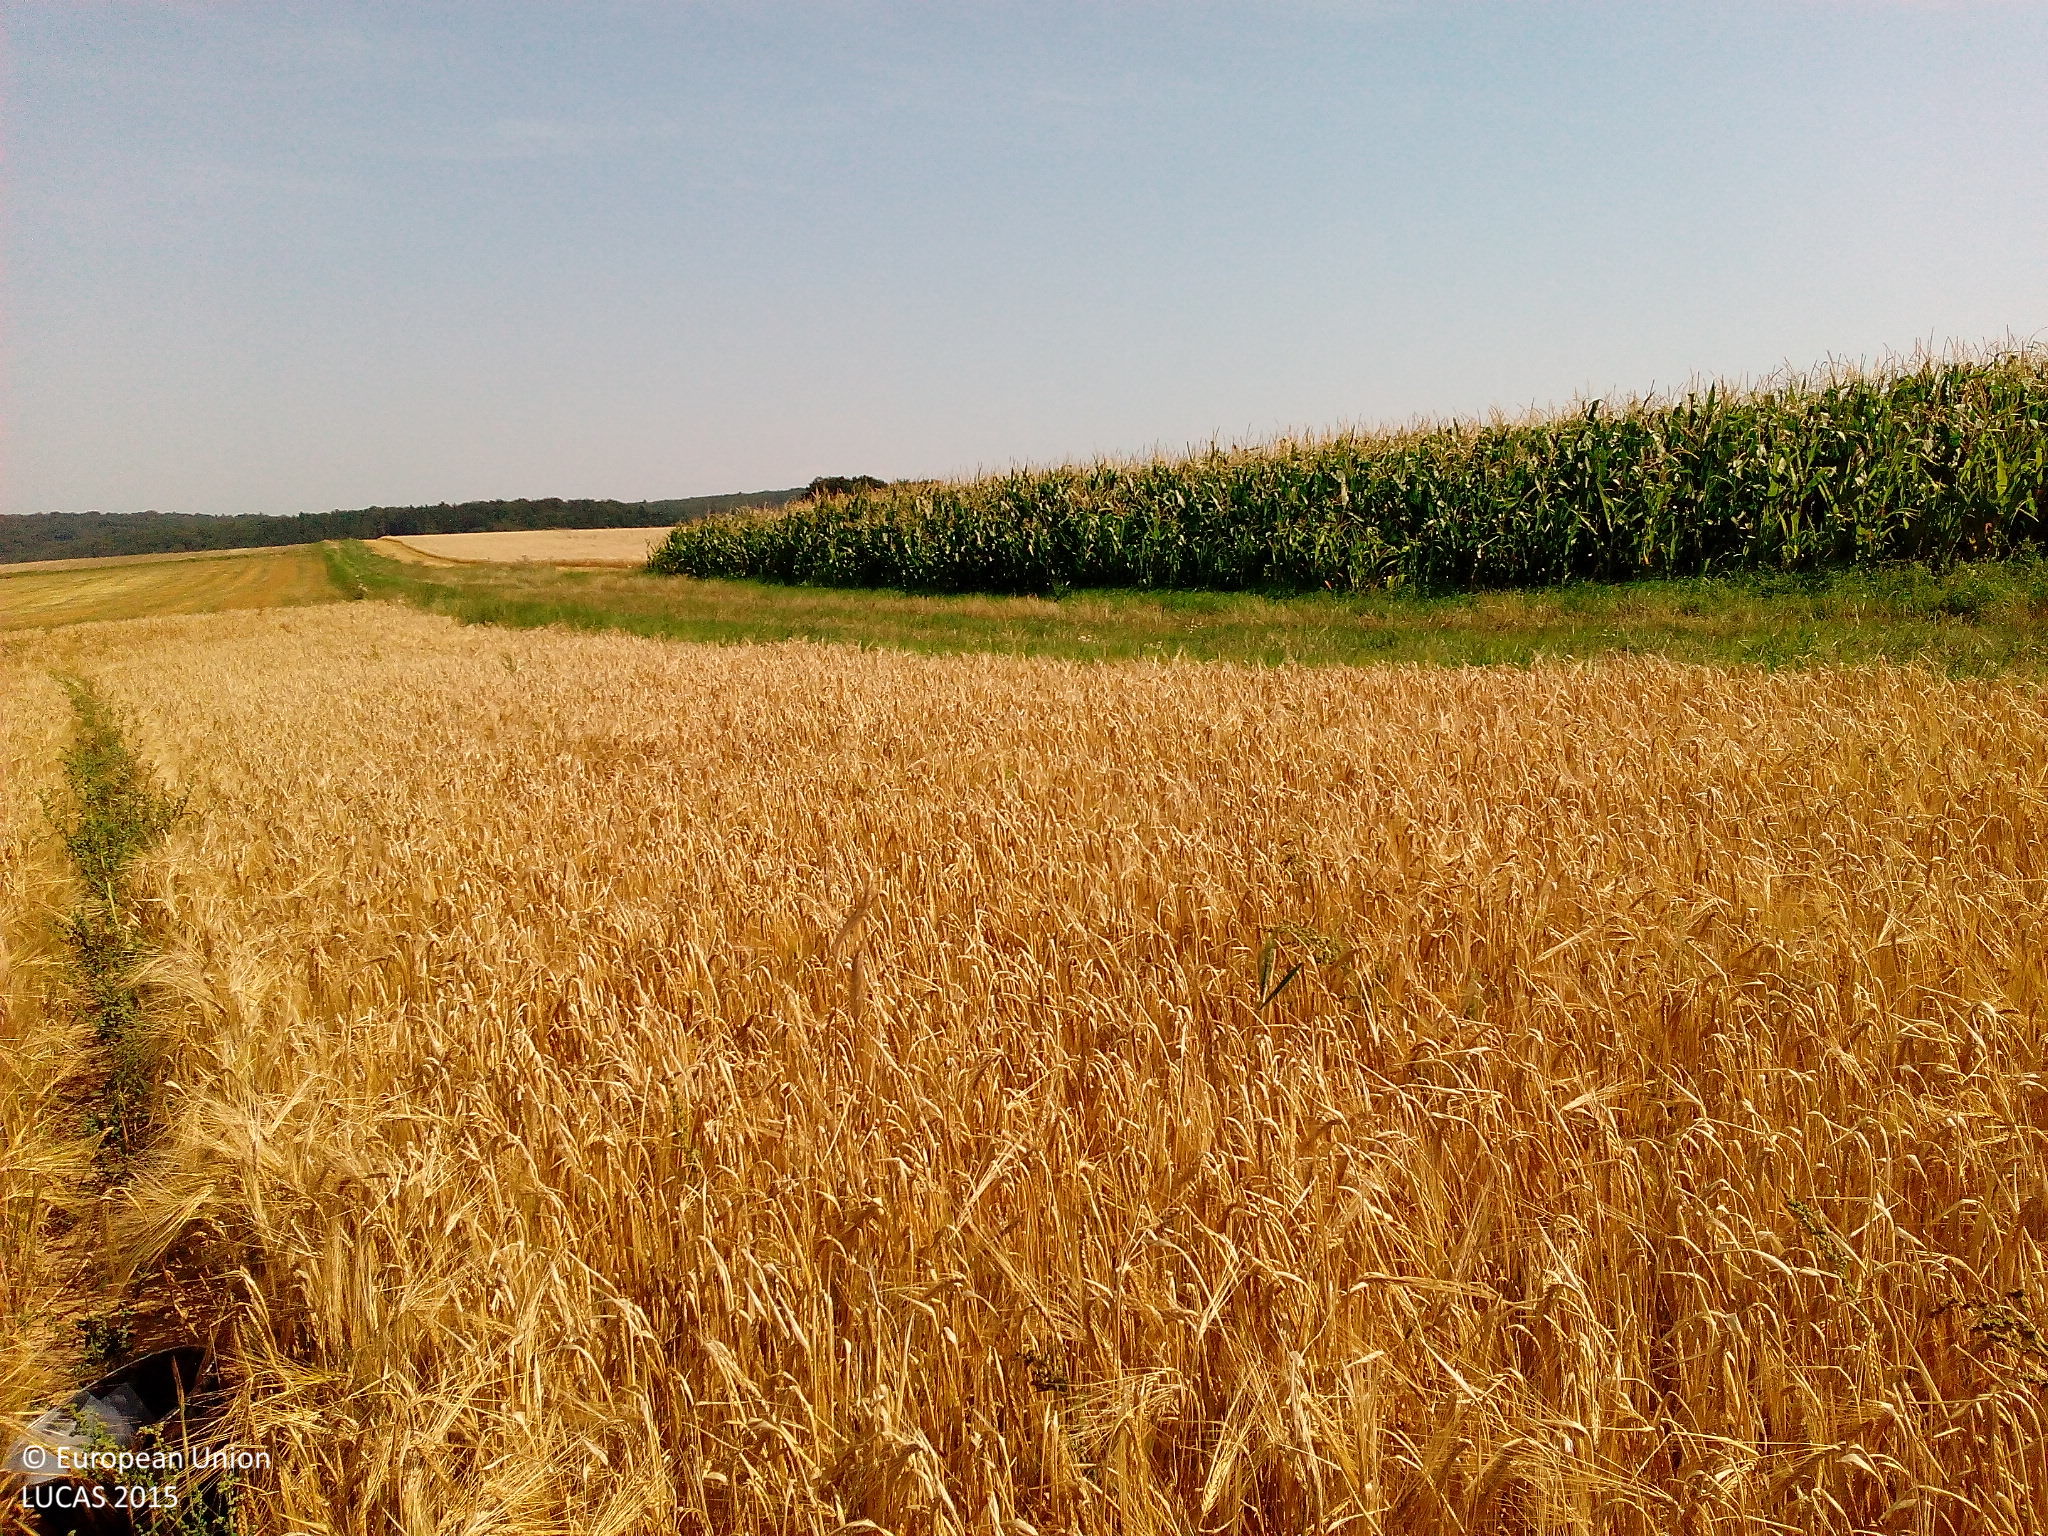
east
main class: Cropland
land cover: Barley
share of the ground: > 75 %
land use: Agriculture (excluding fallow land and kitchen gardens)
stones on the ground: < 10 %
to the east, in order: Barley; Grass margins; Tracks; Grass margins; Maize; Grass margins; Paved roads, cycling and walking lanes; Grass margins; Barley
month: August
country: DE
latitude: 50.8285
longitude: 9.1626
